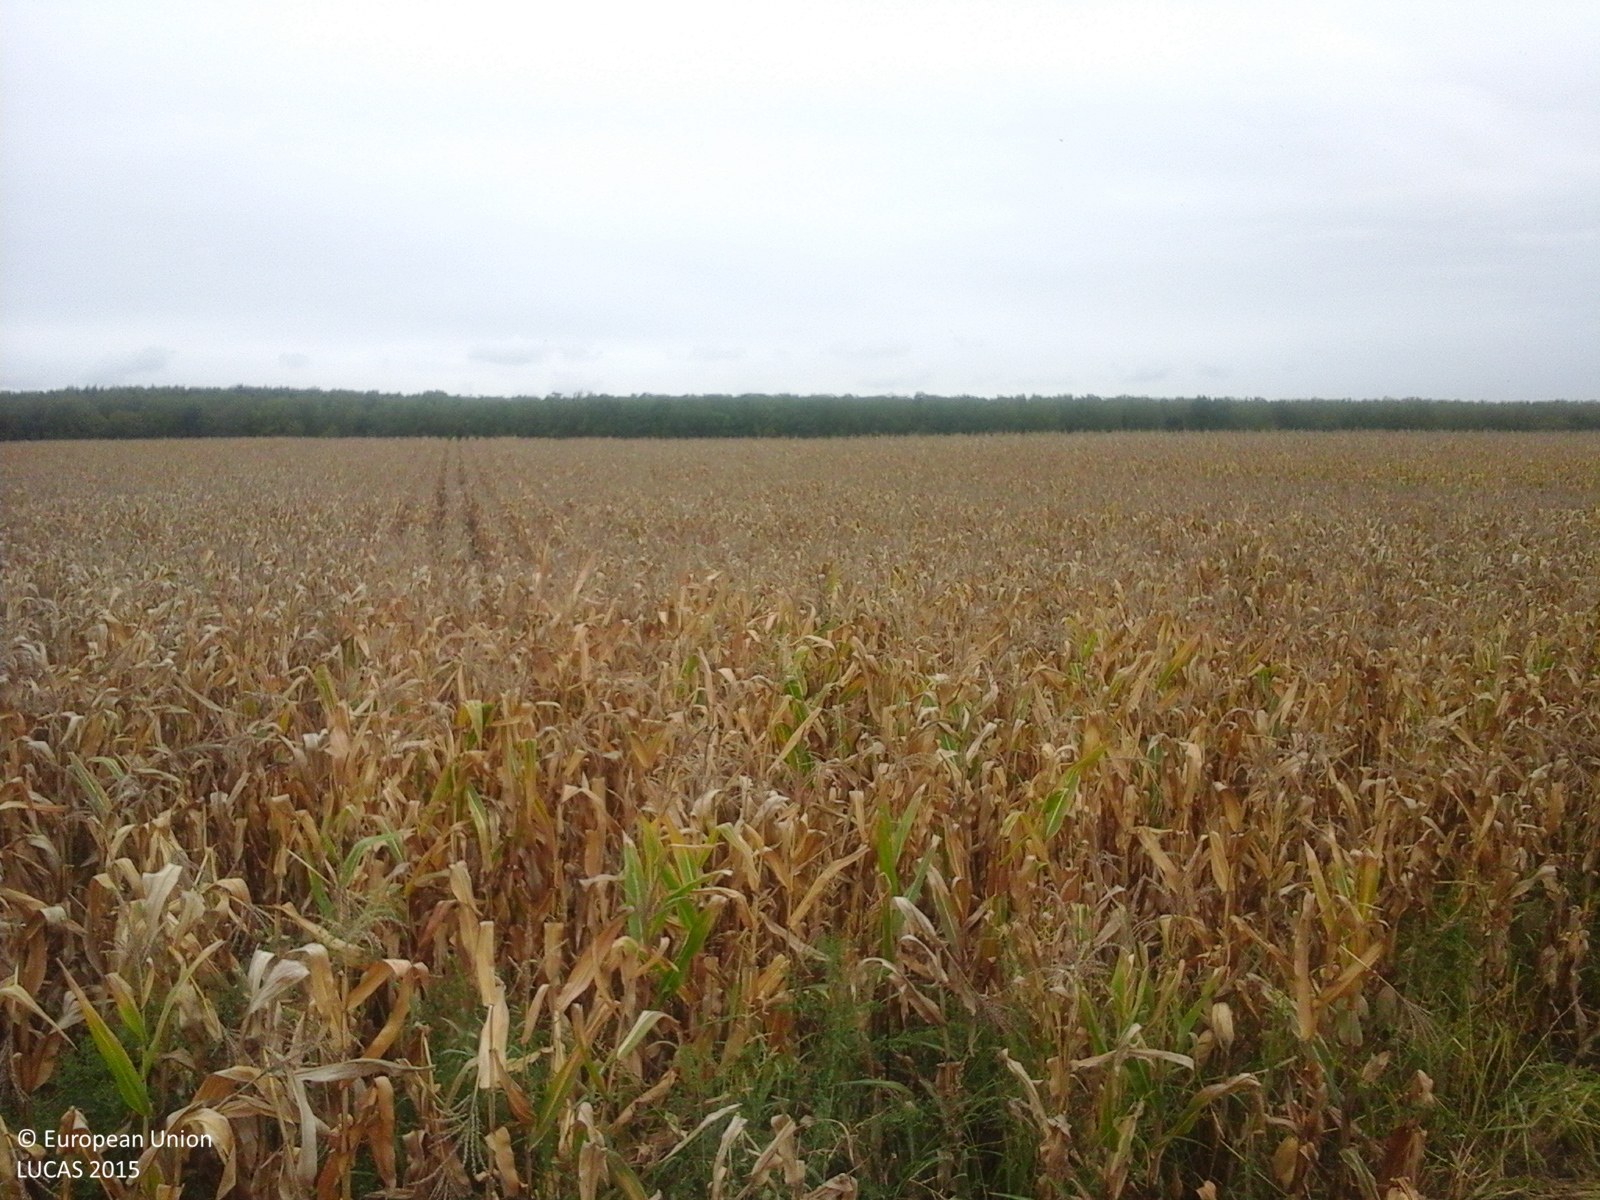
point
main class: Cropland
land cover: Maize
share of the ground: > 75 %
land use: Agriculture (excluding fallow land and kitchen gardens)
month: September
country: RO
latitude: 47.3349
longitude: 21.9453
